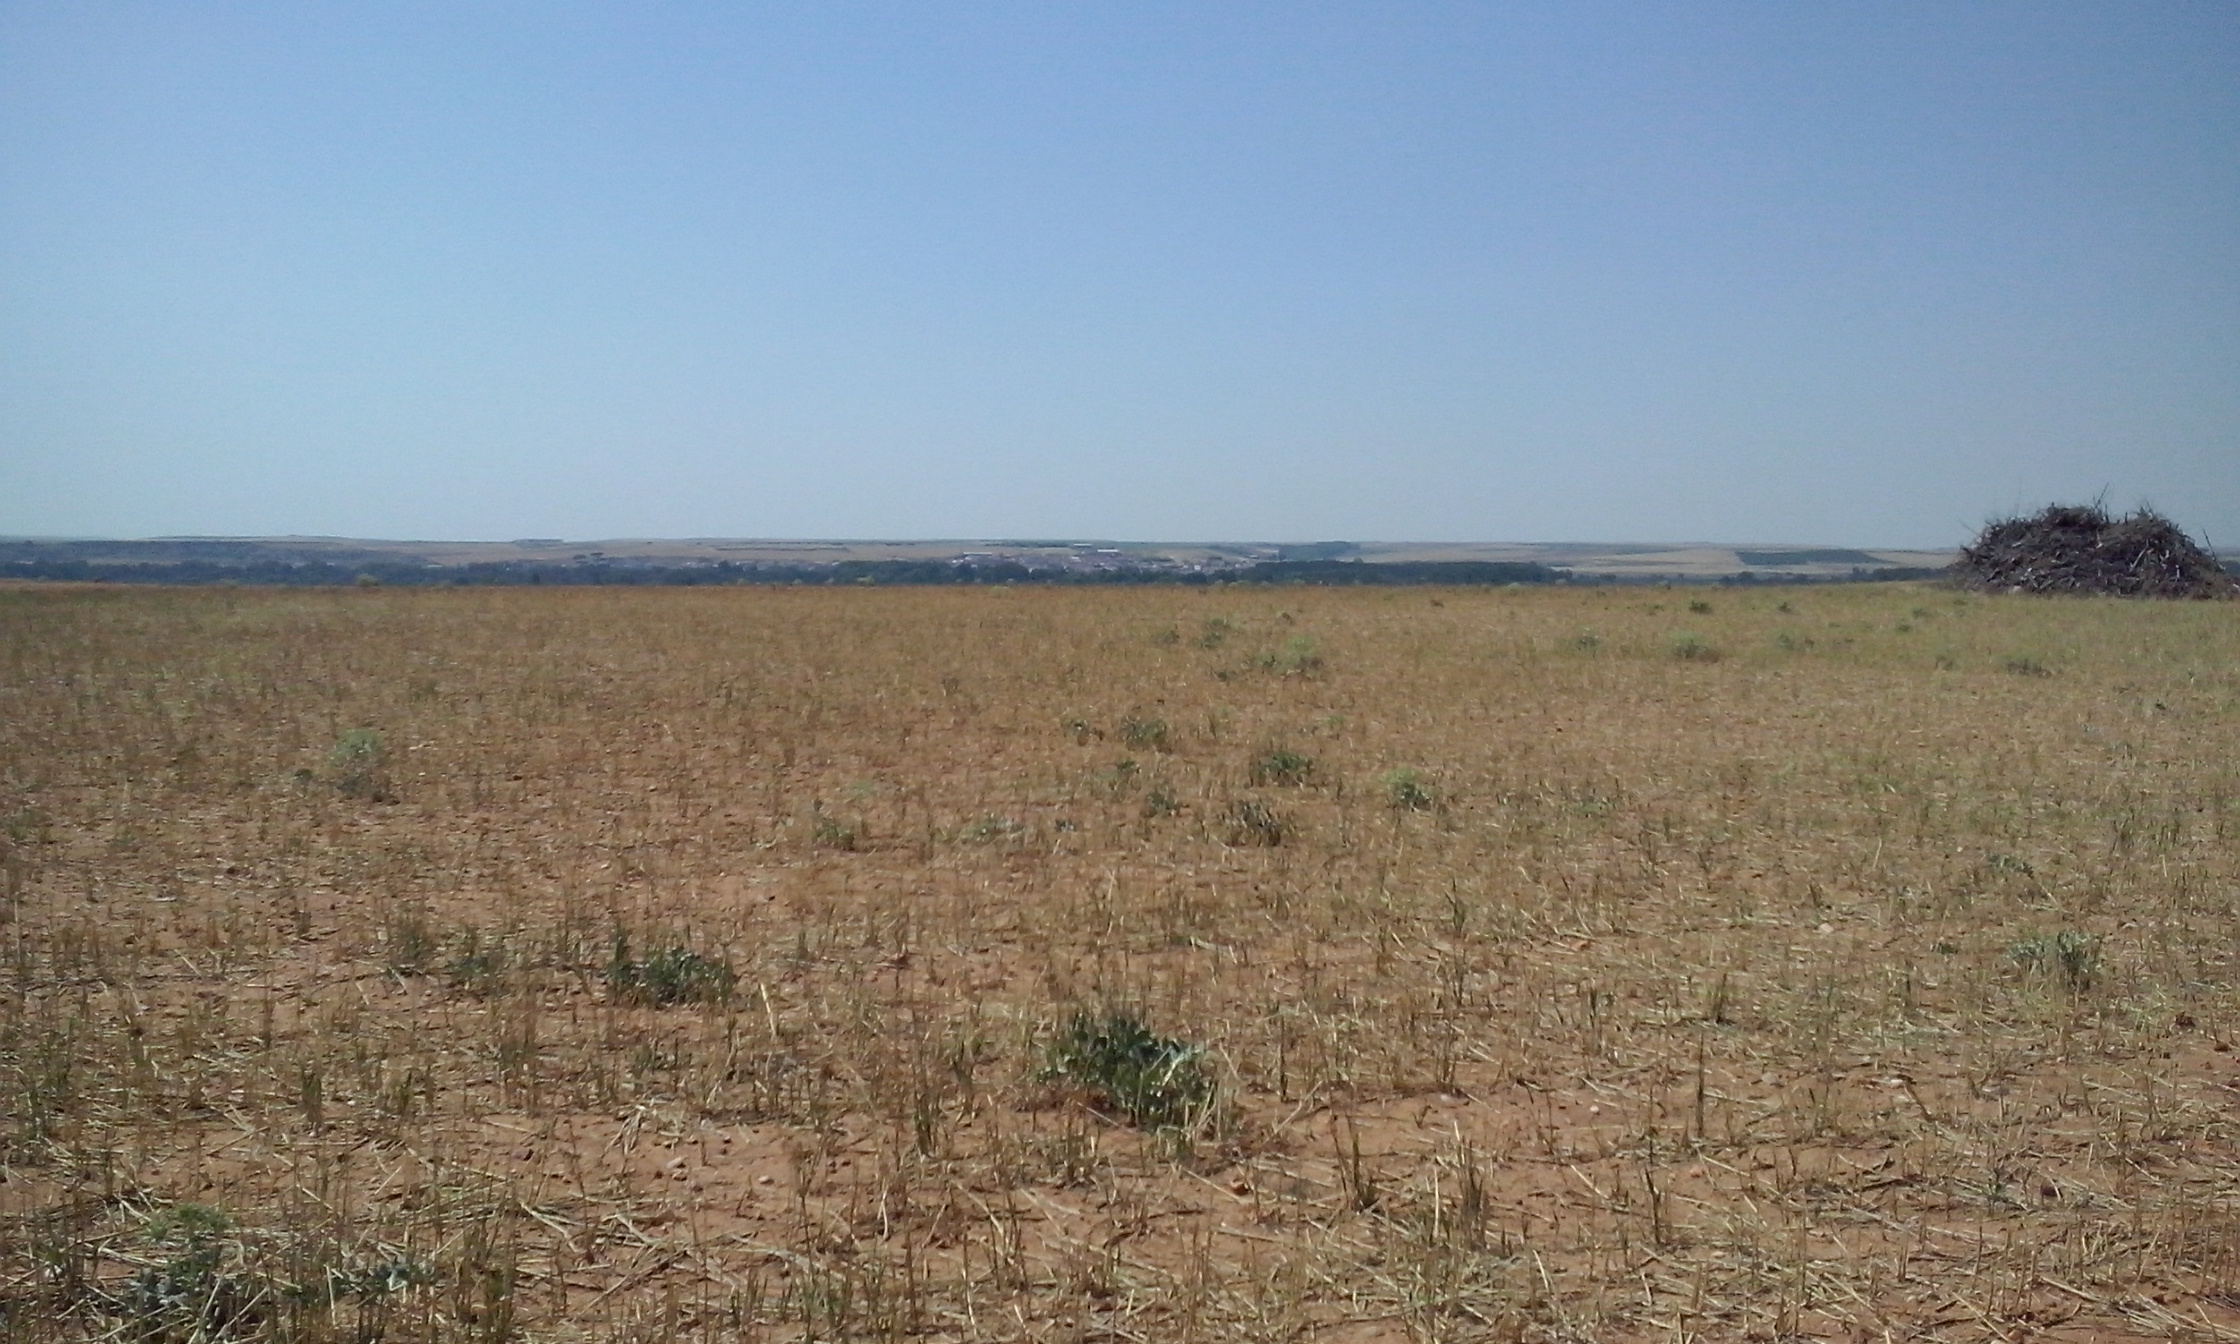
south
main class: Cropland
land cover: Oats
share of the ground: 25 - 50 %
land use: Agriculture (excluding fallow land and kitchen gardens)
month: June
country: ES
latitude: 41.4738
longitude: -5.1261
